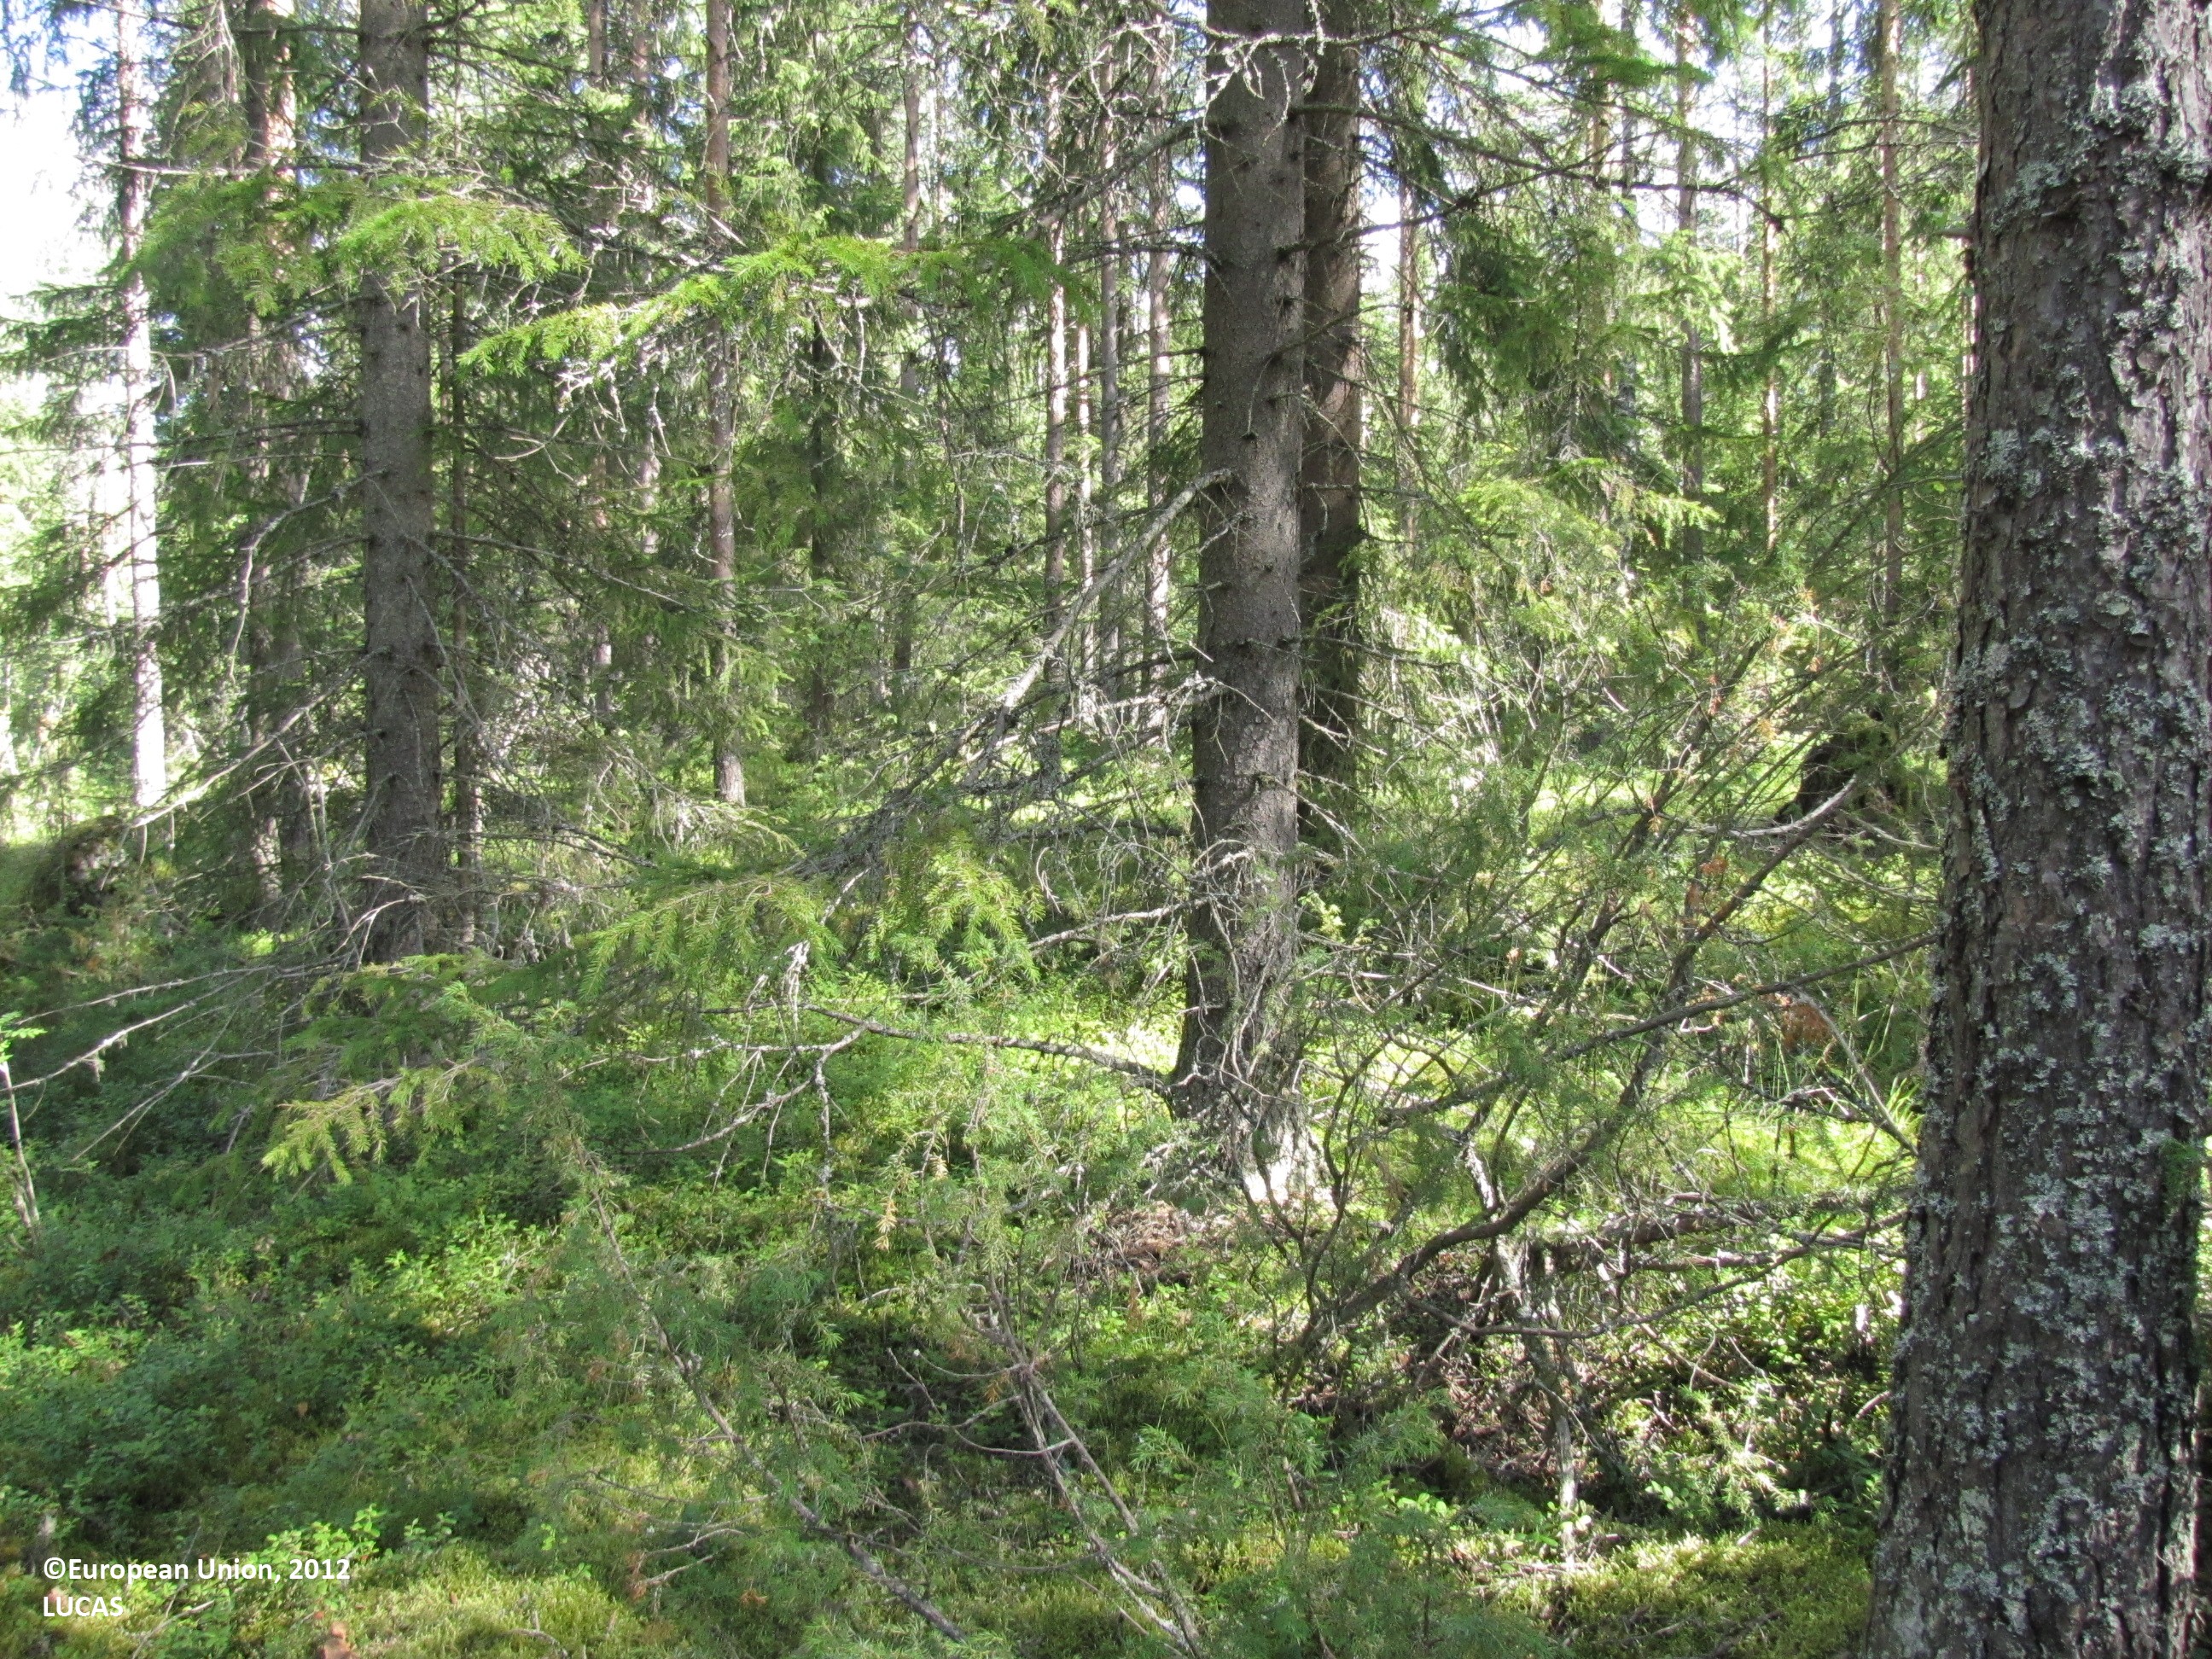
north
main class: Woodland
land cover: Other coniferous woodland
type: boreal forest
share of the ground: > 75 %
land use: Forestry
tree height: > 5 m
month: July
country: FI
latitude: 62.1163
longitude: 23.2376
